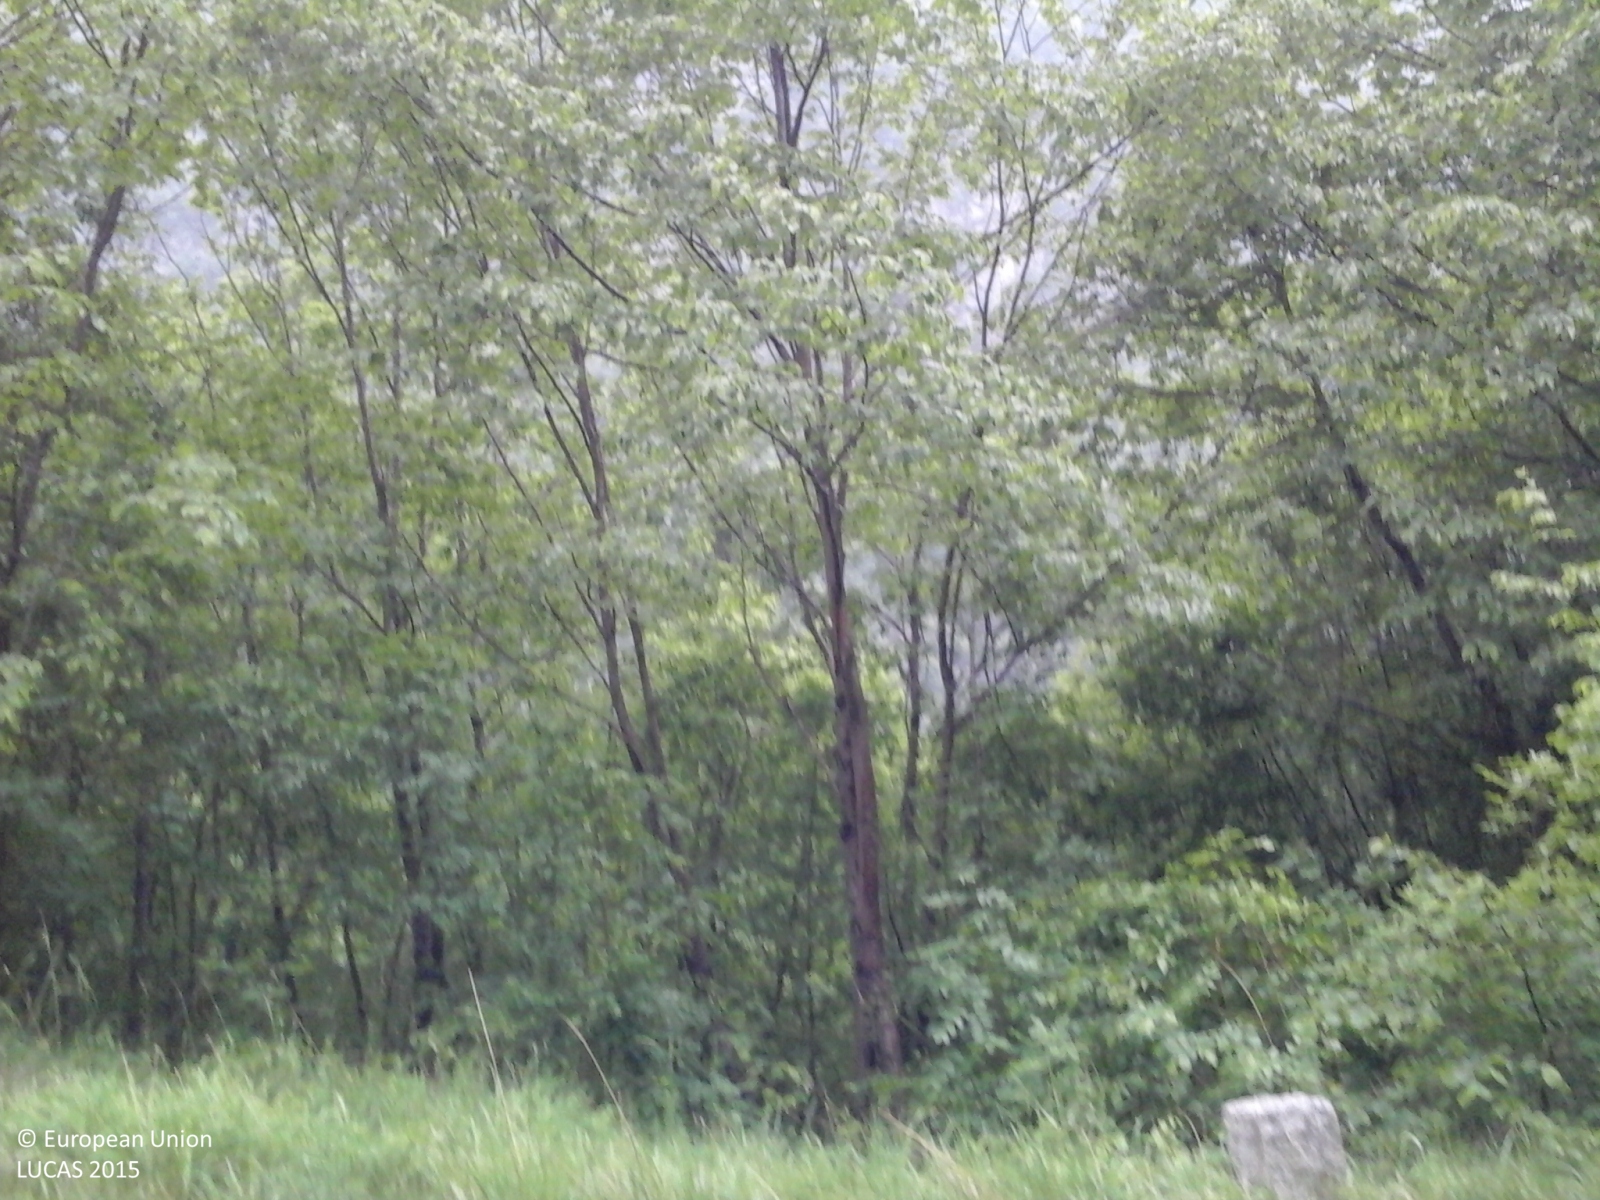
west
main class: Woodland
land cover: Pine dominated coniferous woodland
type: alpine coniferous forest
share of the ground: > 75 %
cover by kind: coniferous forest trees 100 %
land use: Forestry
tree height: > 5 m
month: May
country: IT
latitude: 46.1208
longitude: 11.7446
